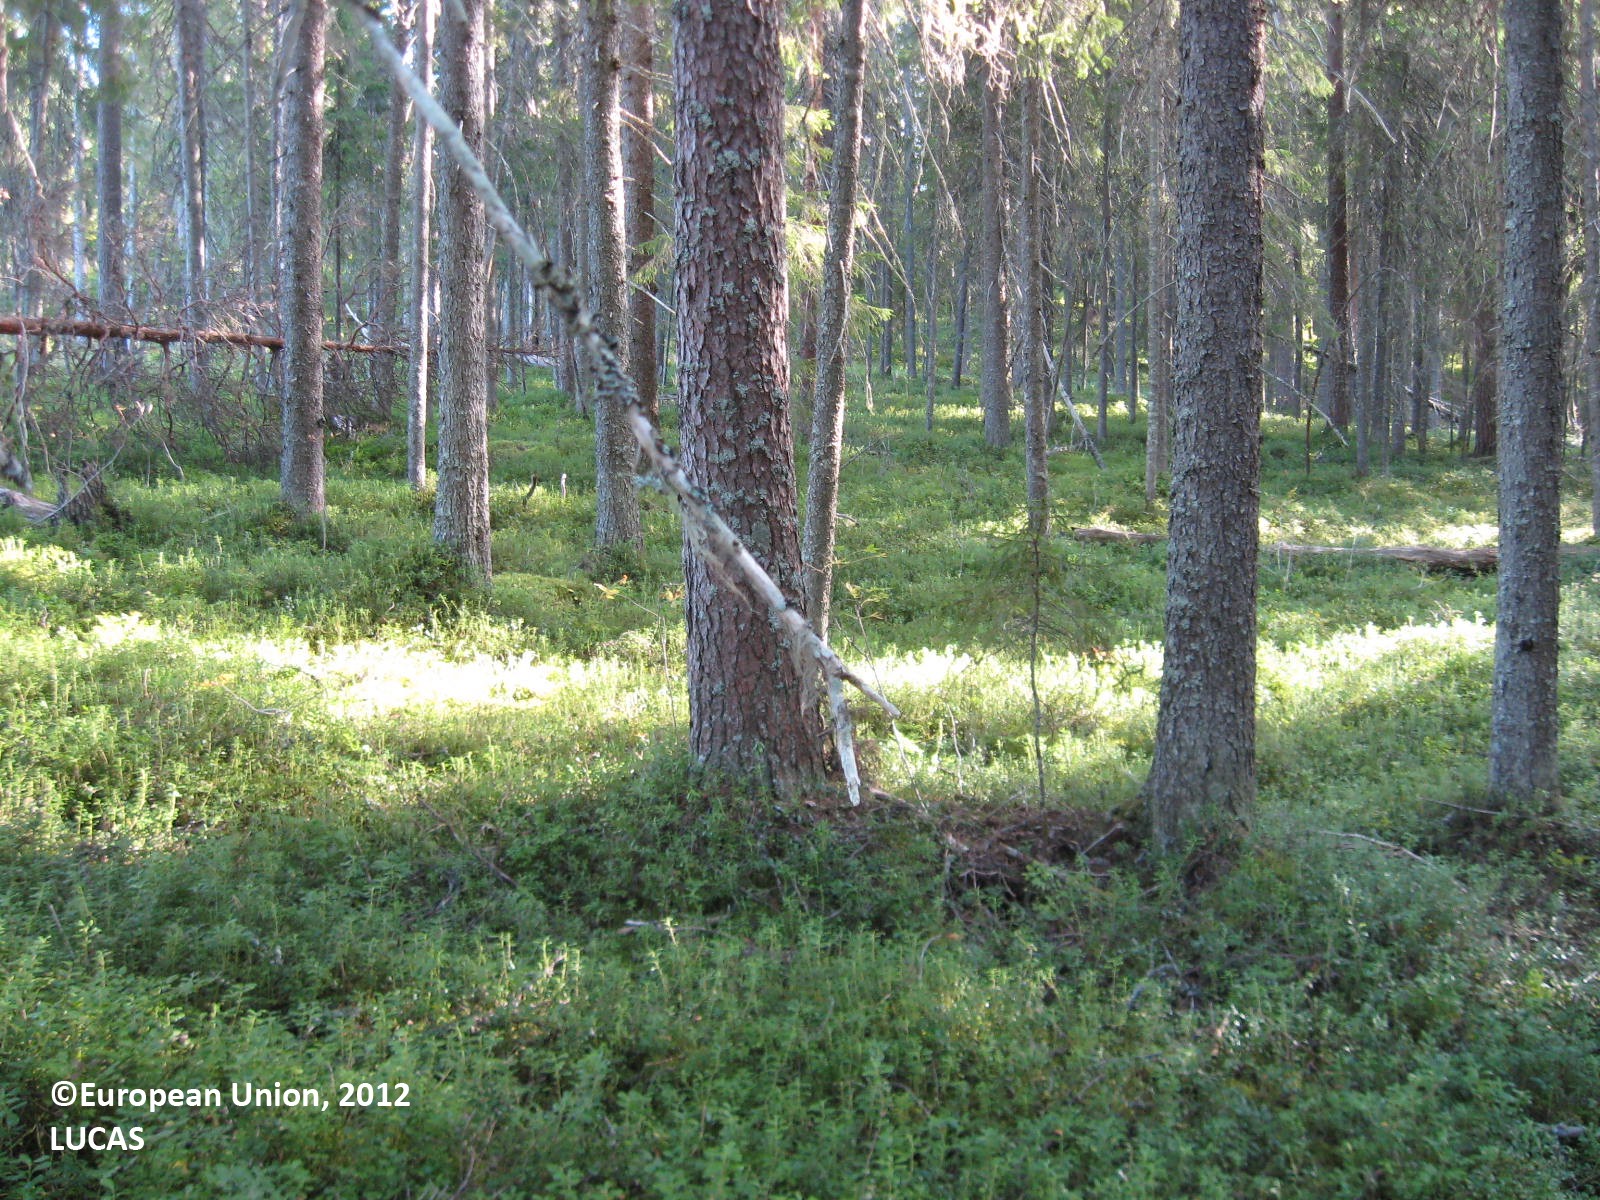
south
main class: Woodland
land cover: Spruce dominated coniferous woodland
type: boreal forest
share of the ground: > 75 %
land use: Forestry
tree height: > 5 m
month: August
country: FI
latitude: 63.8606
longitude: 30.0825
